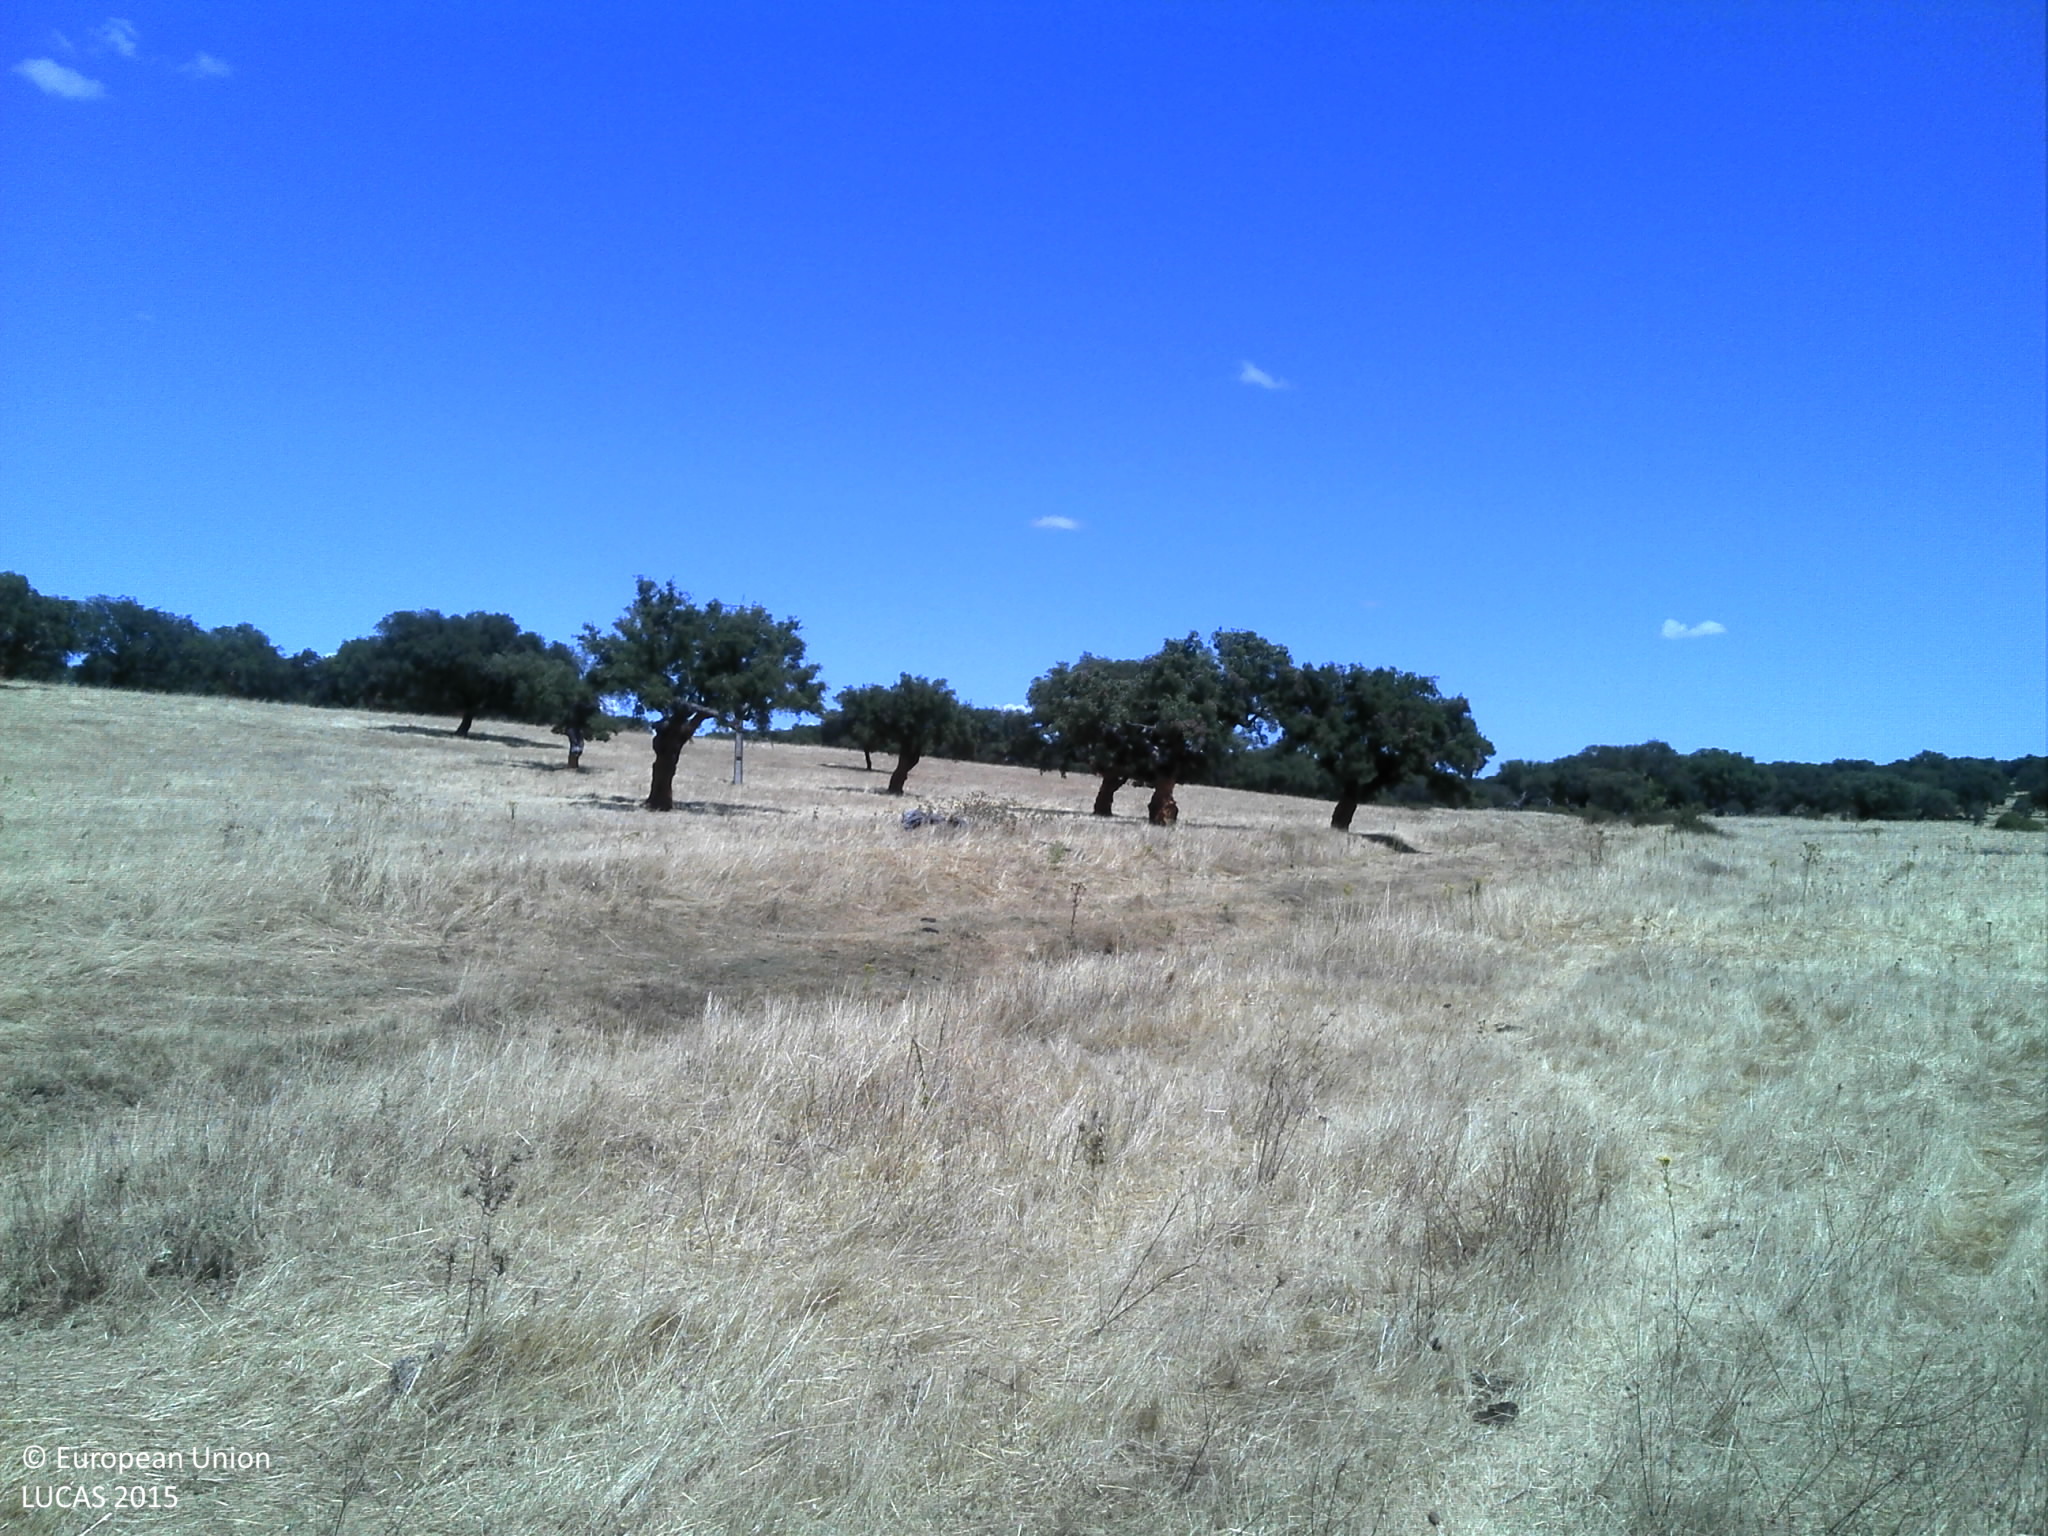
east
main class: Grassland
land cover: Grassland without tree/shrub cover
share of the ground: 50 - 75 %
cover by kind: herbaceous plants 60 %, unconsolidated bare surface 40 %
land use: Agriculture (excluding fallow land and kitchen gardens)
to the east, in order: Grassland without tree/shrub cover; Rivers and streams; Grassland without tree/shrub cover; Broadleaved woodland; Grassland without tree/shrub cover; Single bushes/trees; Grassland without tree/shrub cover
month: July
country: PT
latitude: 39.1899
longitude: -7.4411
